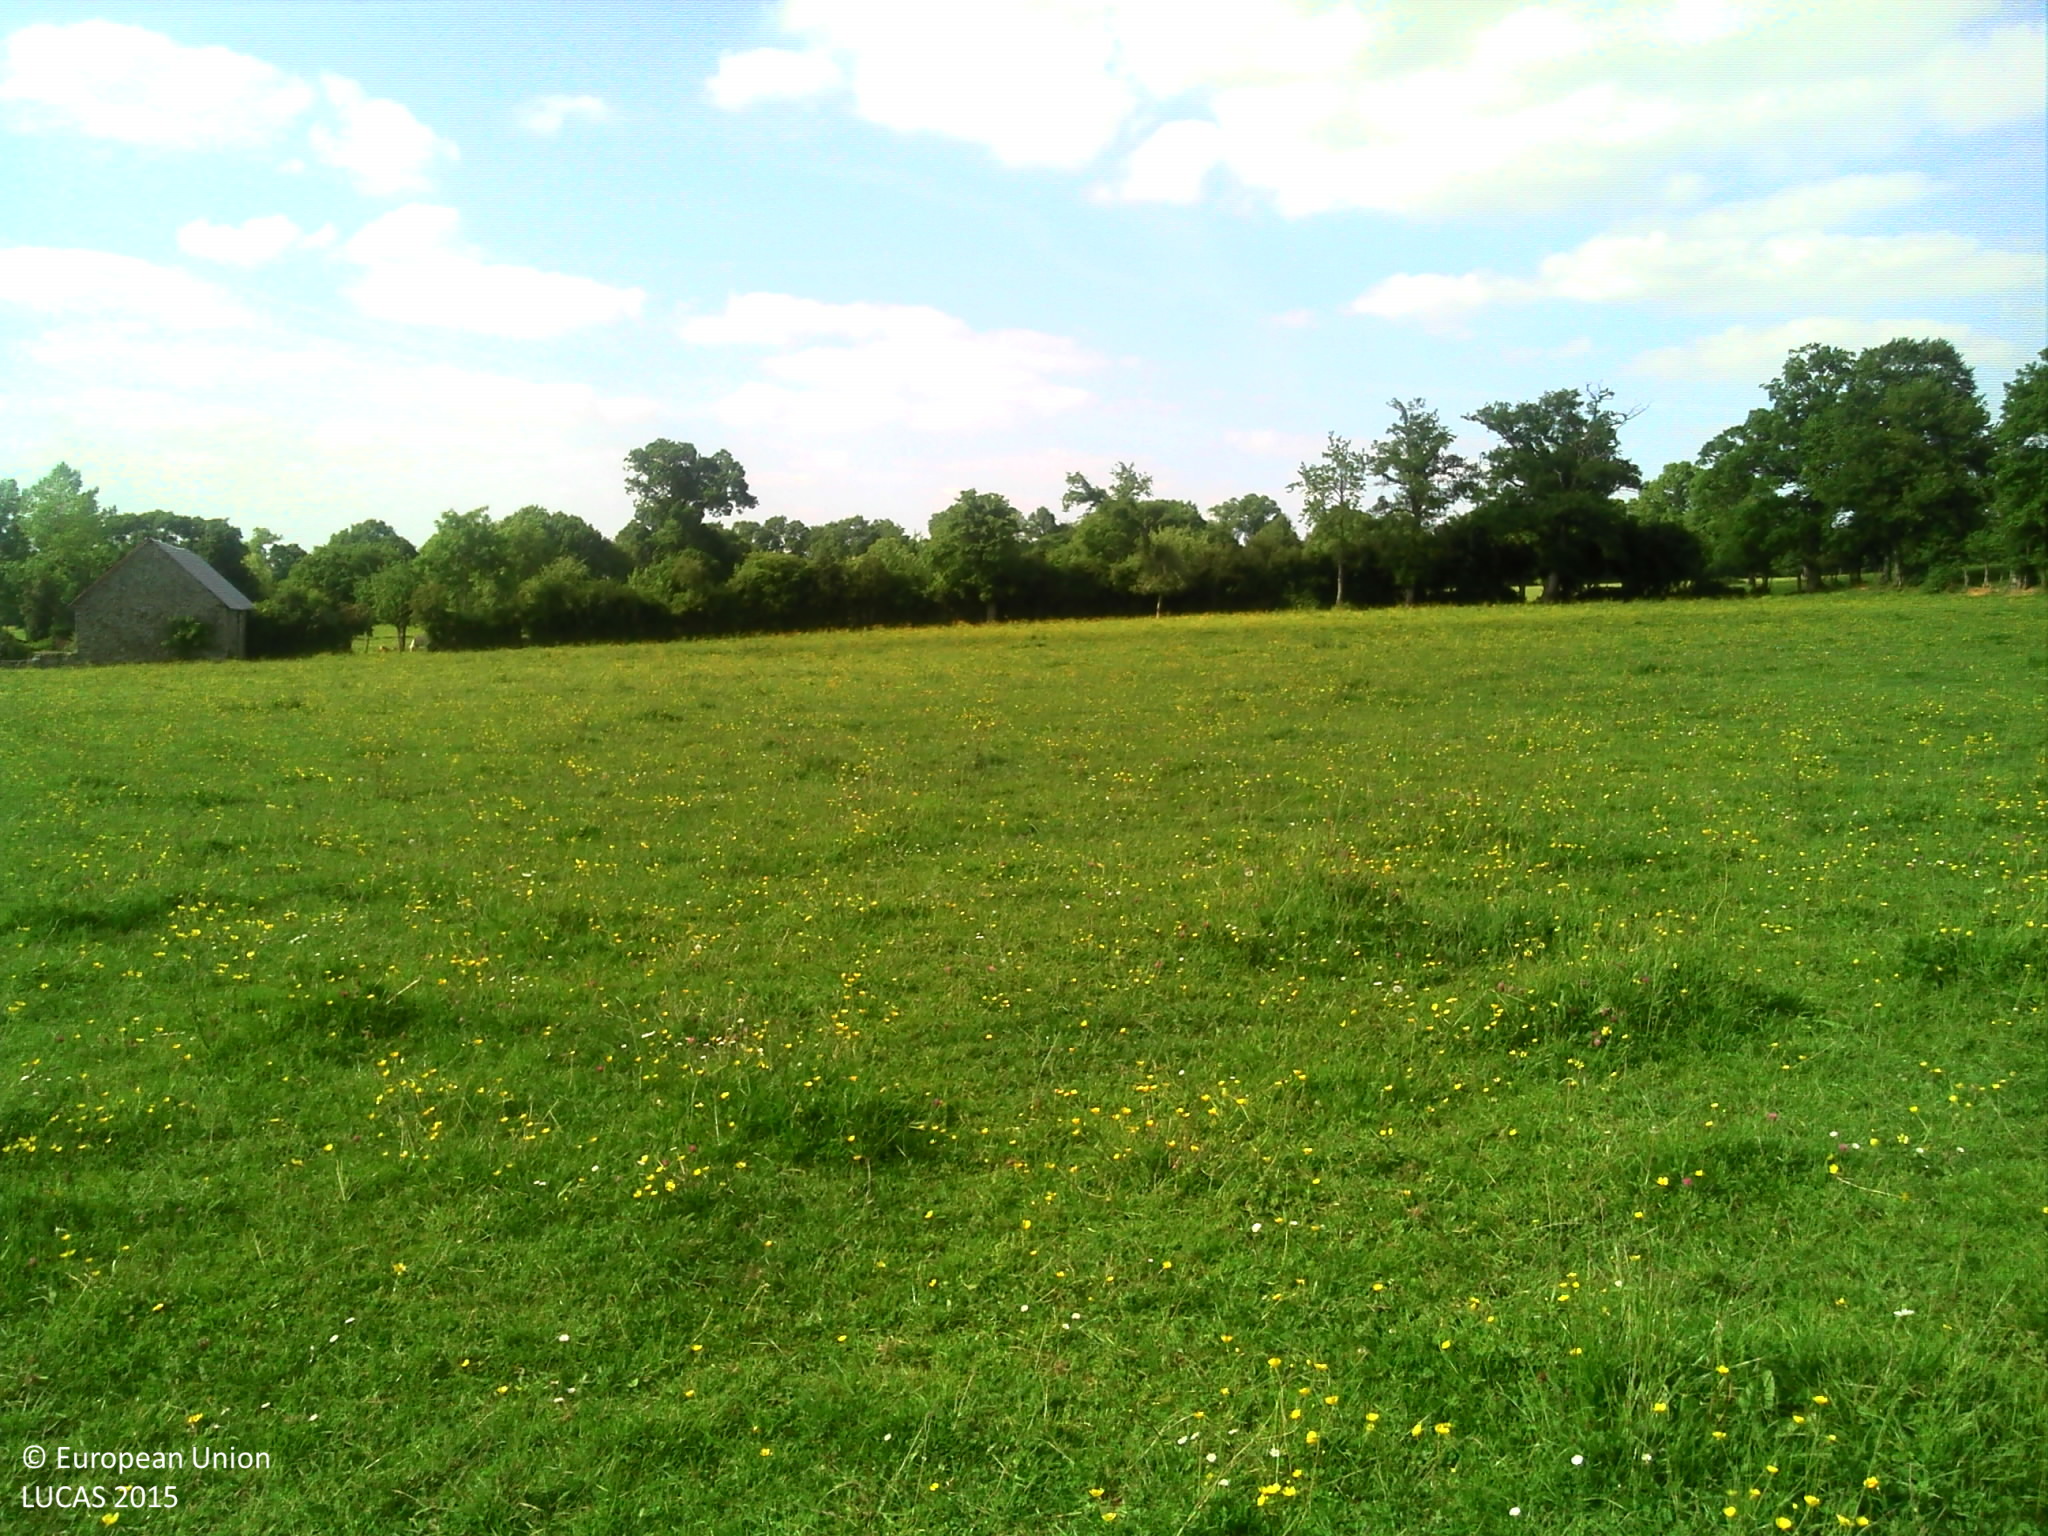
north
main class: Grassland
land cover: Grassland without tree/shrub cover
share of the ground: > 75 %
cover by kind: herbaceous plants 95 %, shrubs 5 %
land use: Agriculture (excluding fallow land and kitchen gardens)
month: May
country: FR
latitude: 48.6940
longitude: -0.1804
